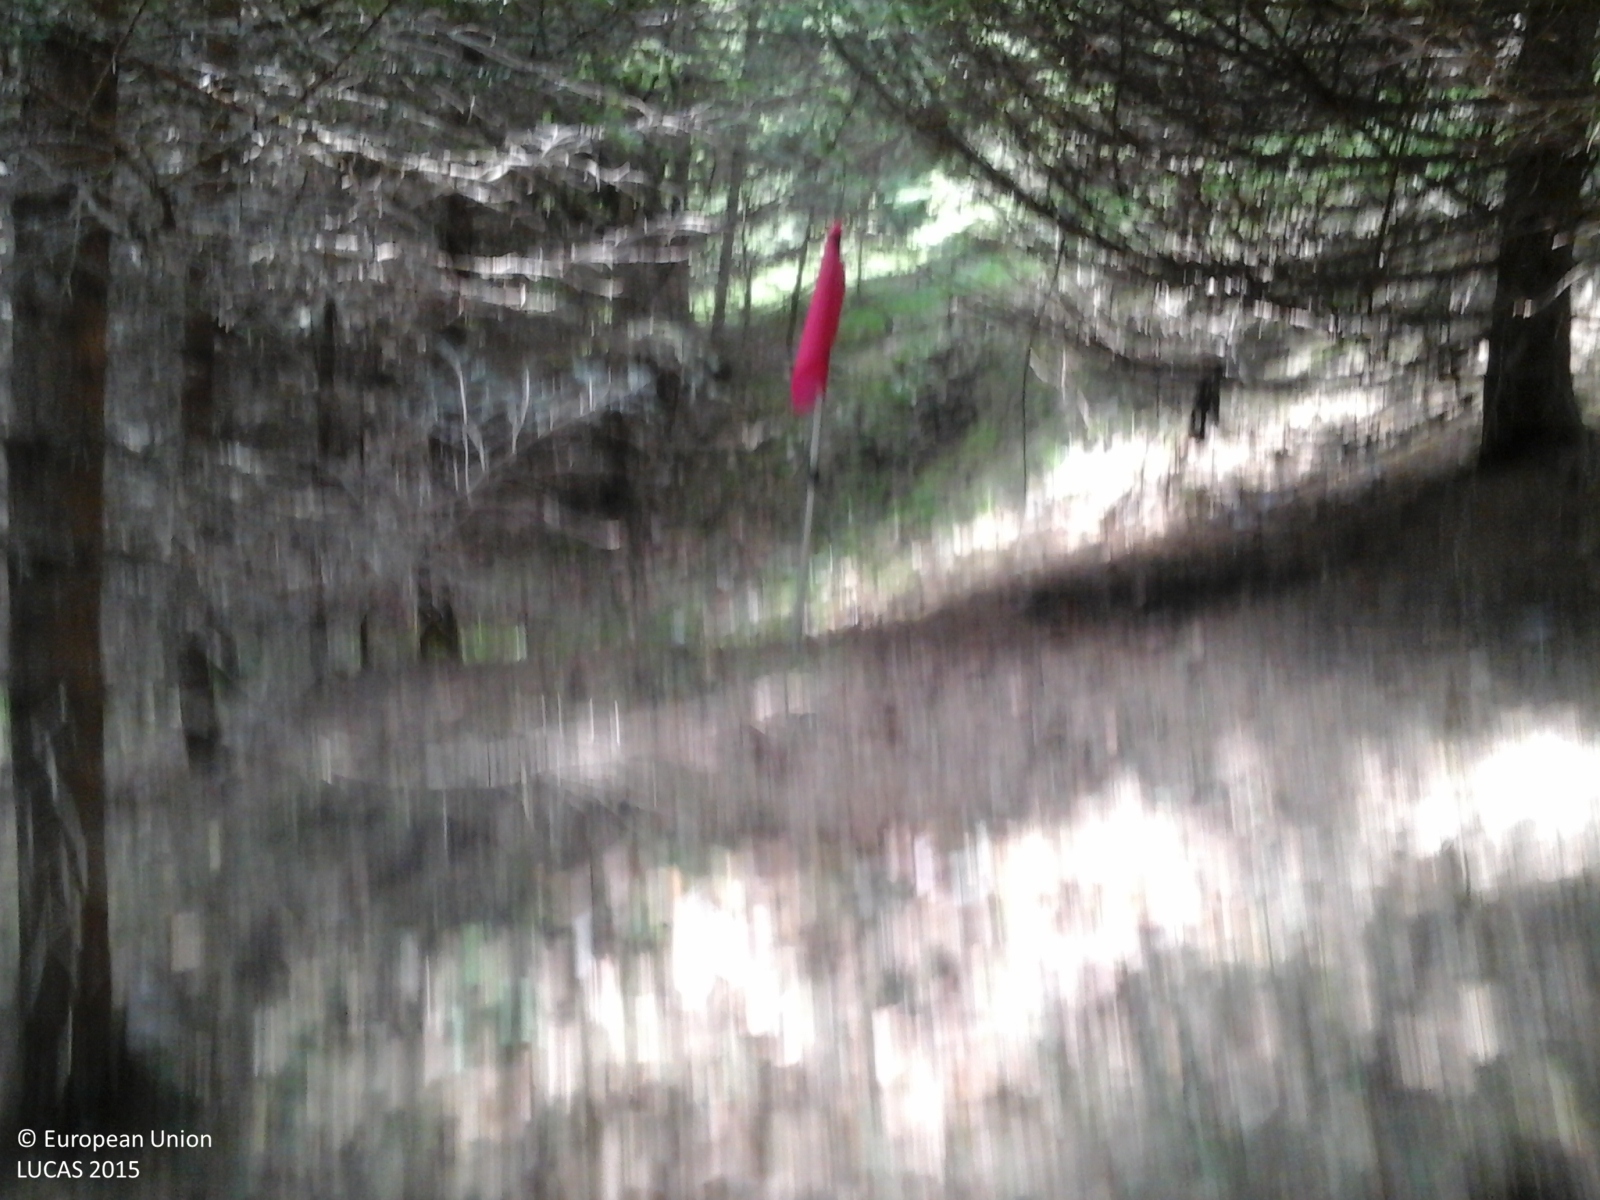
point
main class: Woodland
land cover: Spruce dominated coniferous woodland
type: alpine coniferous forest
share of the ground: > 75 %
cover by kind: coniferous forest trees 100 %
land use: Forestry
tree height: > 5 m
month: May
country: IT
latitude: 46.1892
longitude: 11.9540
